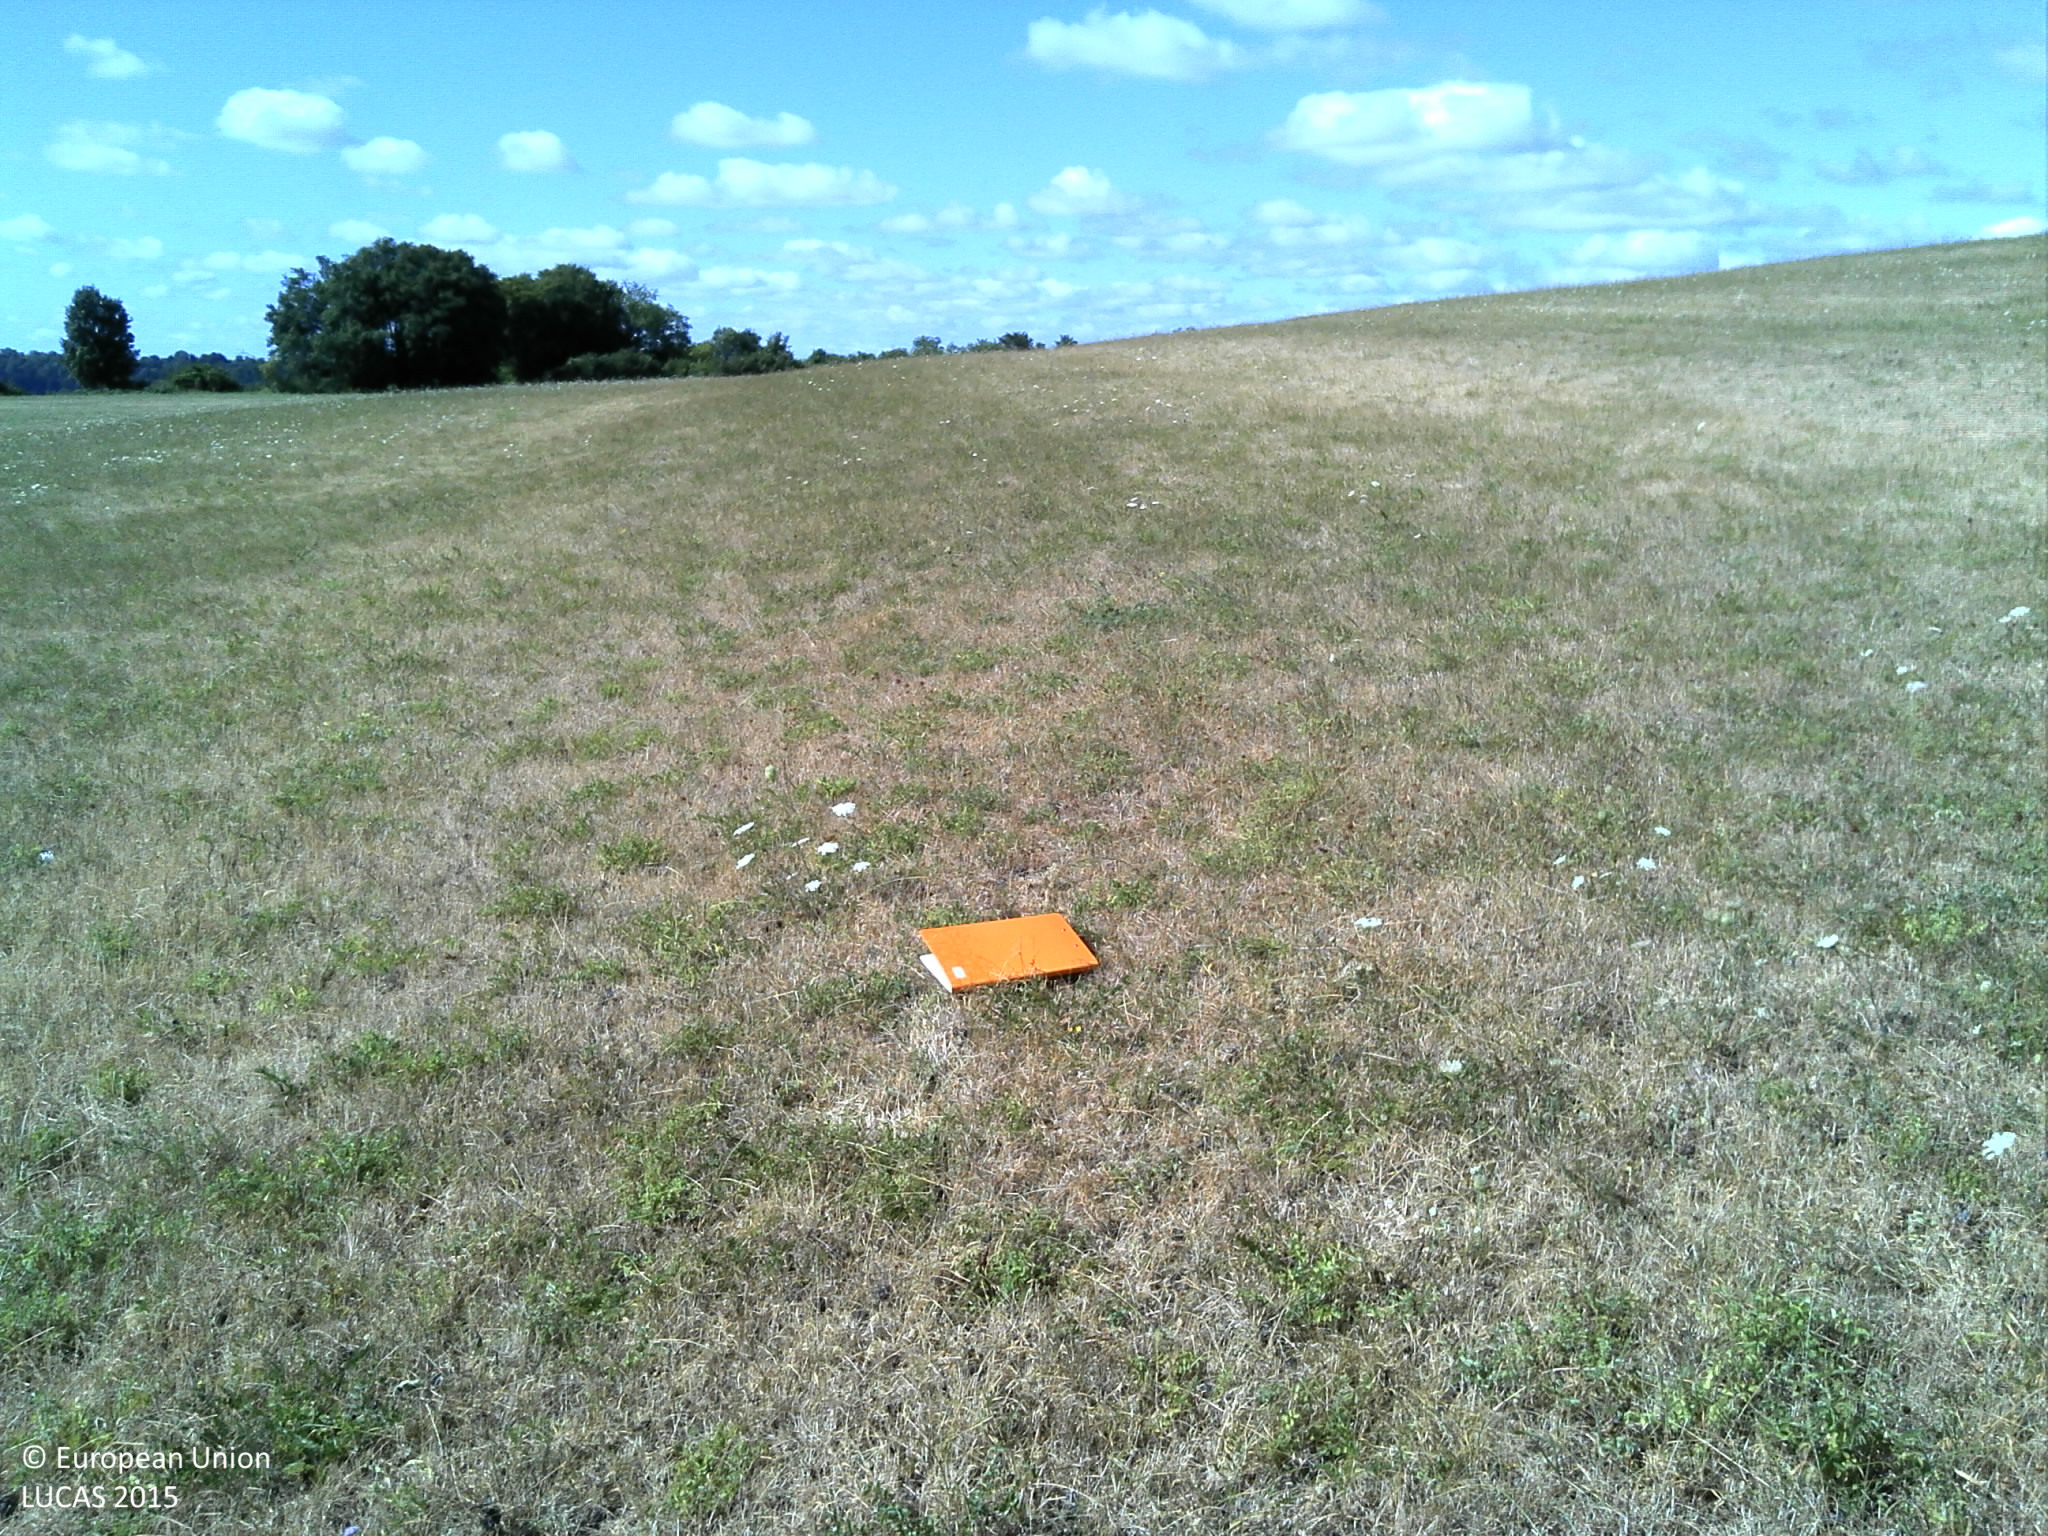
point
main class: Grassland
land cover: Grassland without tree/shrub cover
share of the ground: > 75 %
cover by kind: herbaceous plants 100 %
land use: Agriculture (excluding fallow land and kitchen gardens)
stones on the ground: 10 - 25 %
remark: Harvested field
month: July
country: FR
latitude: 48.2401
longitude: 5.9742
